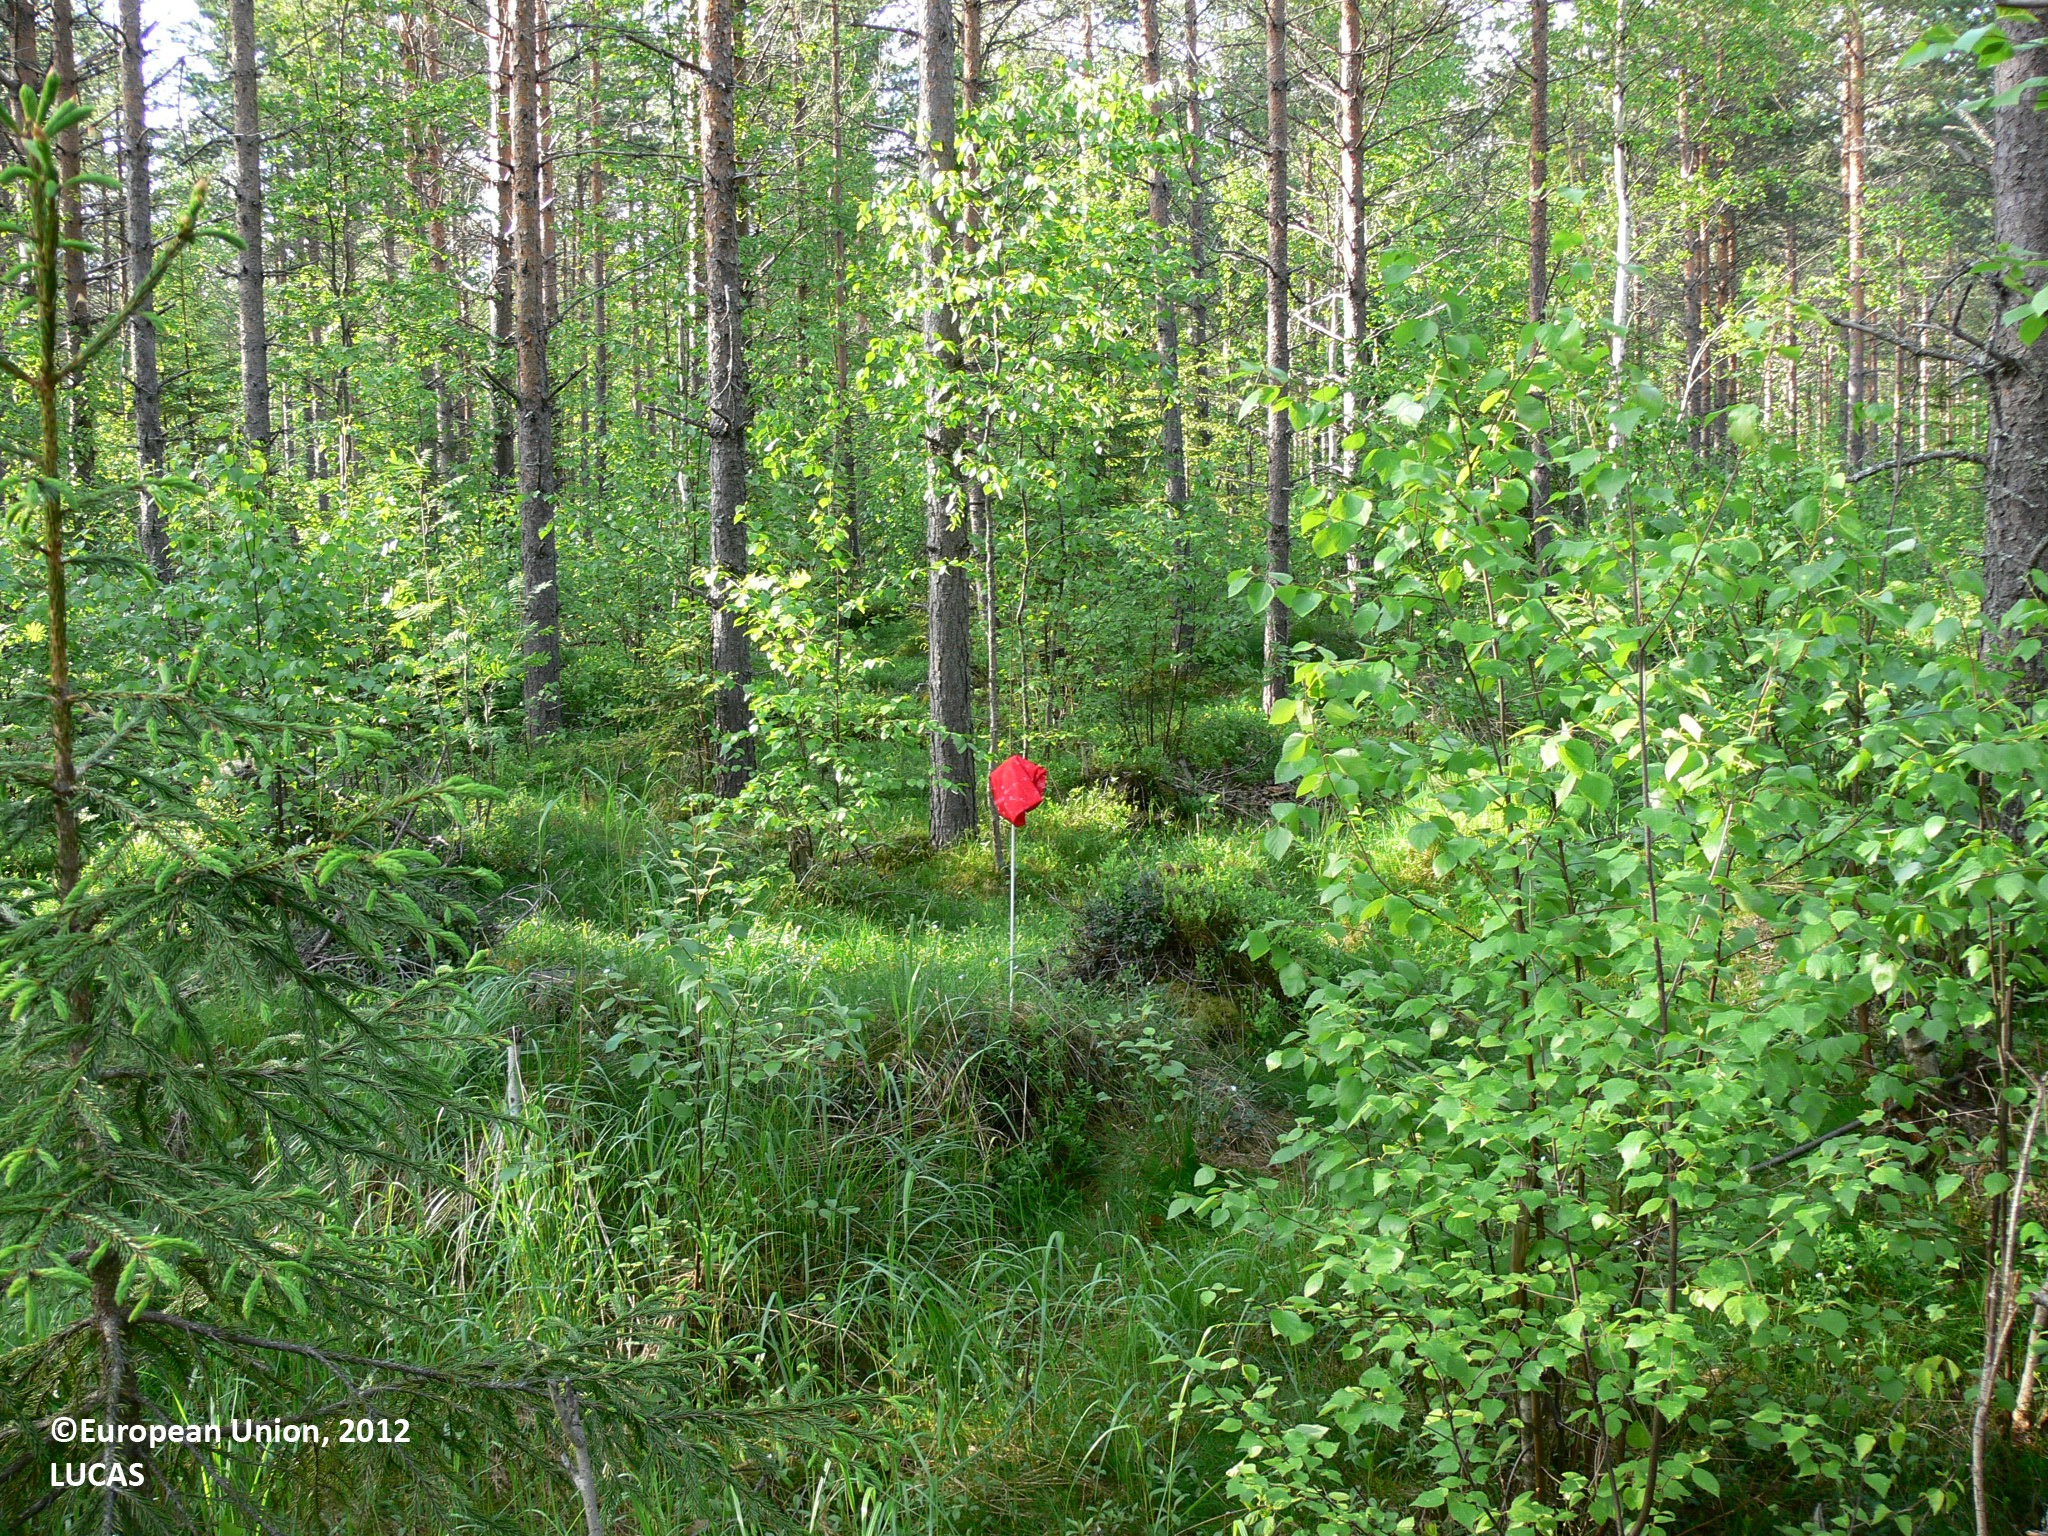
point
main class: Woodland
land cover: Pine dominated coniferous woodland
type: boreal forest
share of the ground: 50 - 75 %
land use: Forestry
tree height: > 5 m
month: June
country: FI
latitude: 62.3742
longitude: 30.2416
